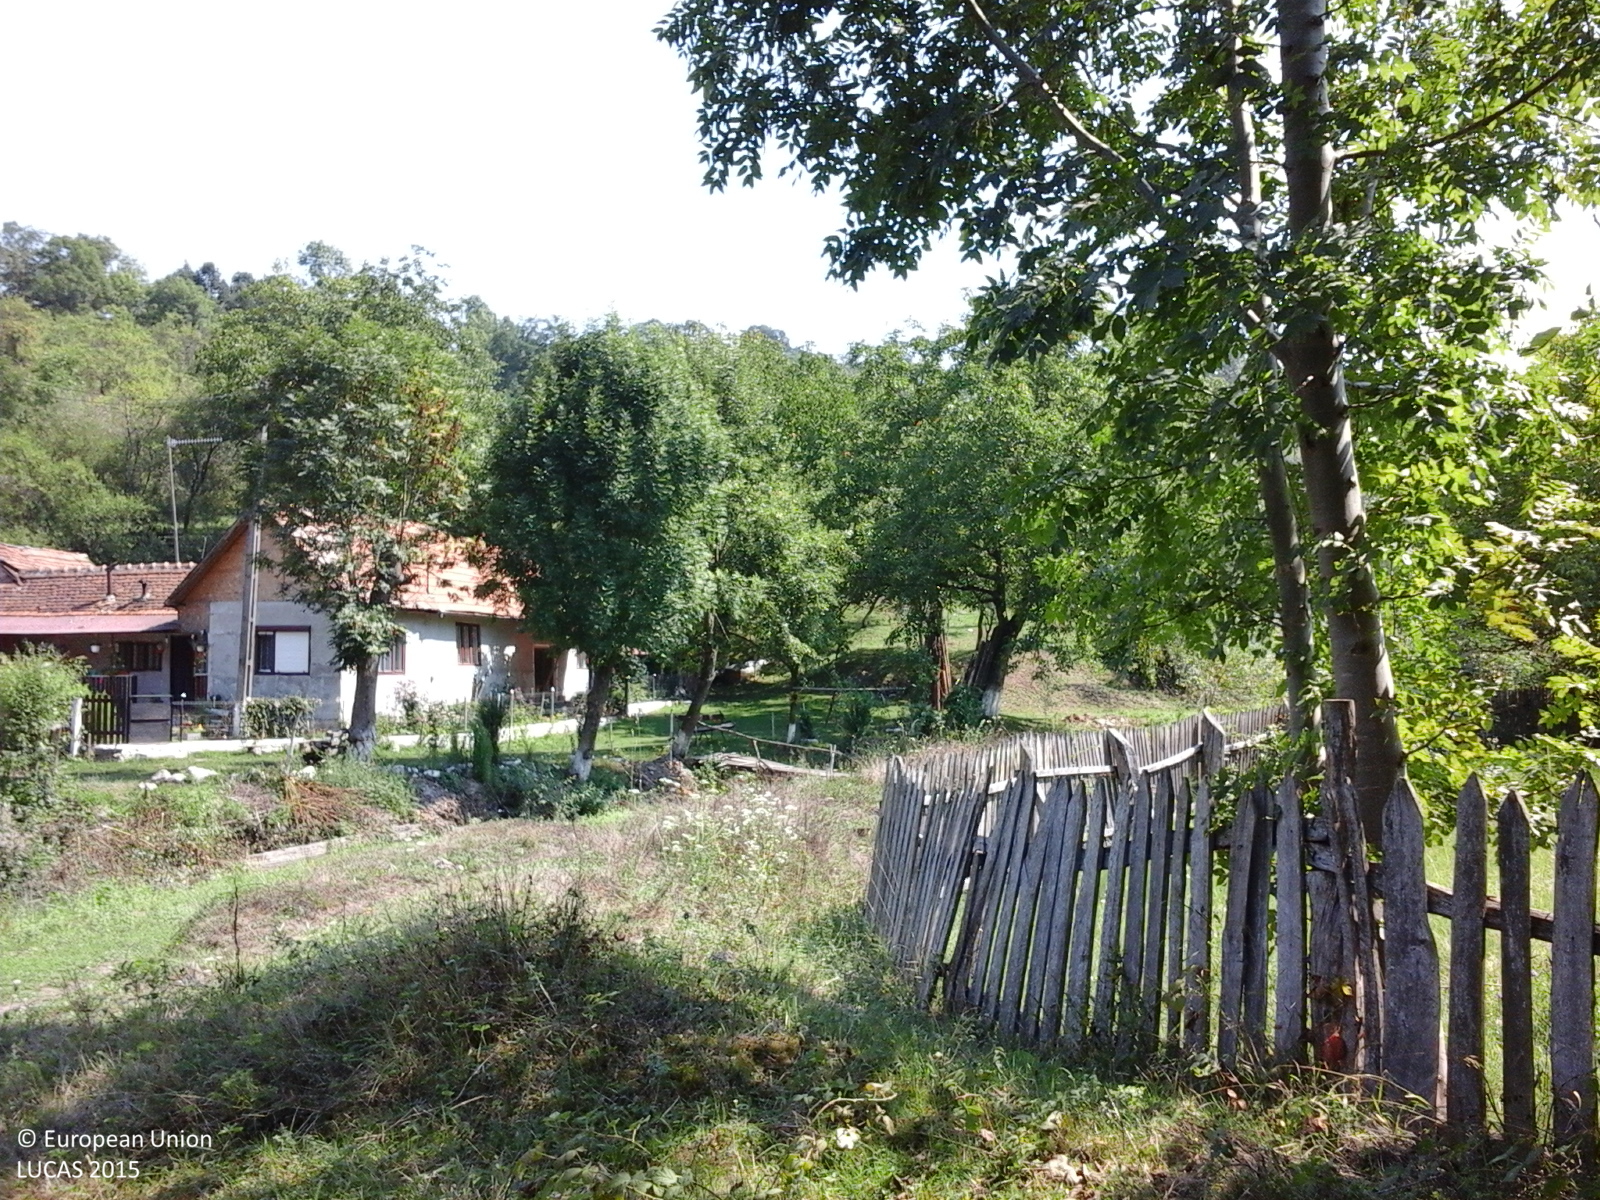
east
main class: Grassland
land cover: Grassland with sparse tree/shrub cover
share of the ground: > 75 %
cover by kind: herbaceous plants 85 %, shrubs 10 %, broadleaved forest trees 5 %
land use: Fallow land
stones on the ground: 10 - 25 %
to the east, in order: Grassland with sparse tree/shrub cover; Fences; Grassland without tree/shrub cover; Fences; Grassland without tree/shrub cover; Rivers and streams; Nuts trees; Tracks; Nuts trees; Fences; Grassland without tree/shrub cover; Other fruit trees and berries; Fences; Tracks; Fences; Arable land (only in case pi)
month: August
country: RO
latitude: 46.2448
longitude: 22.0930
